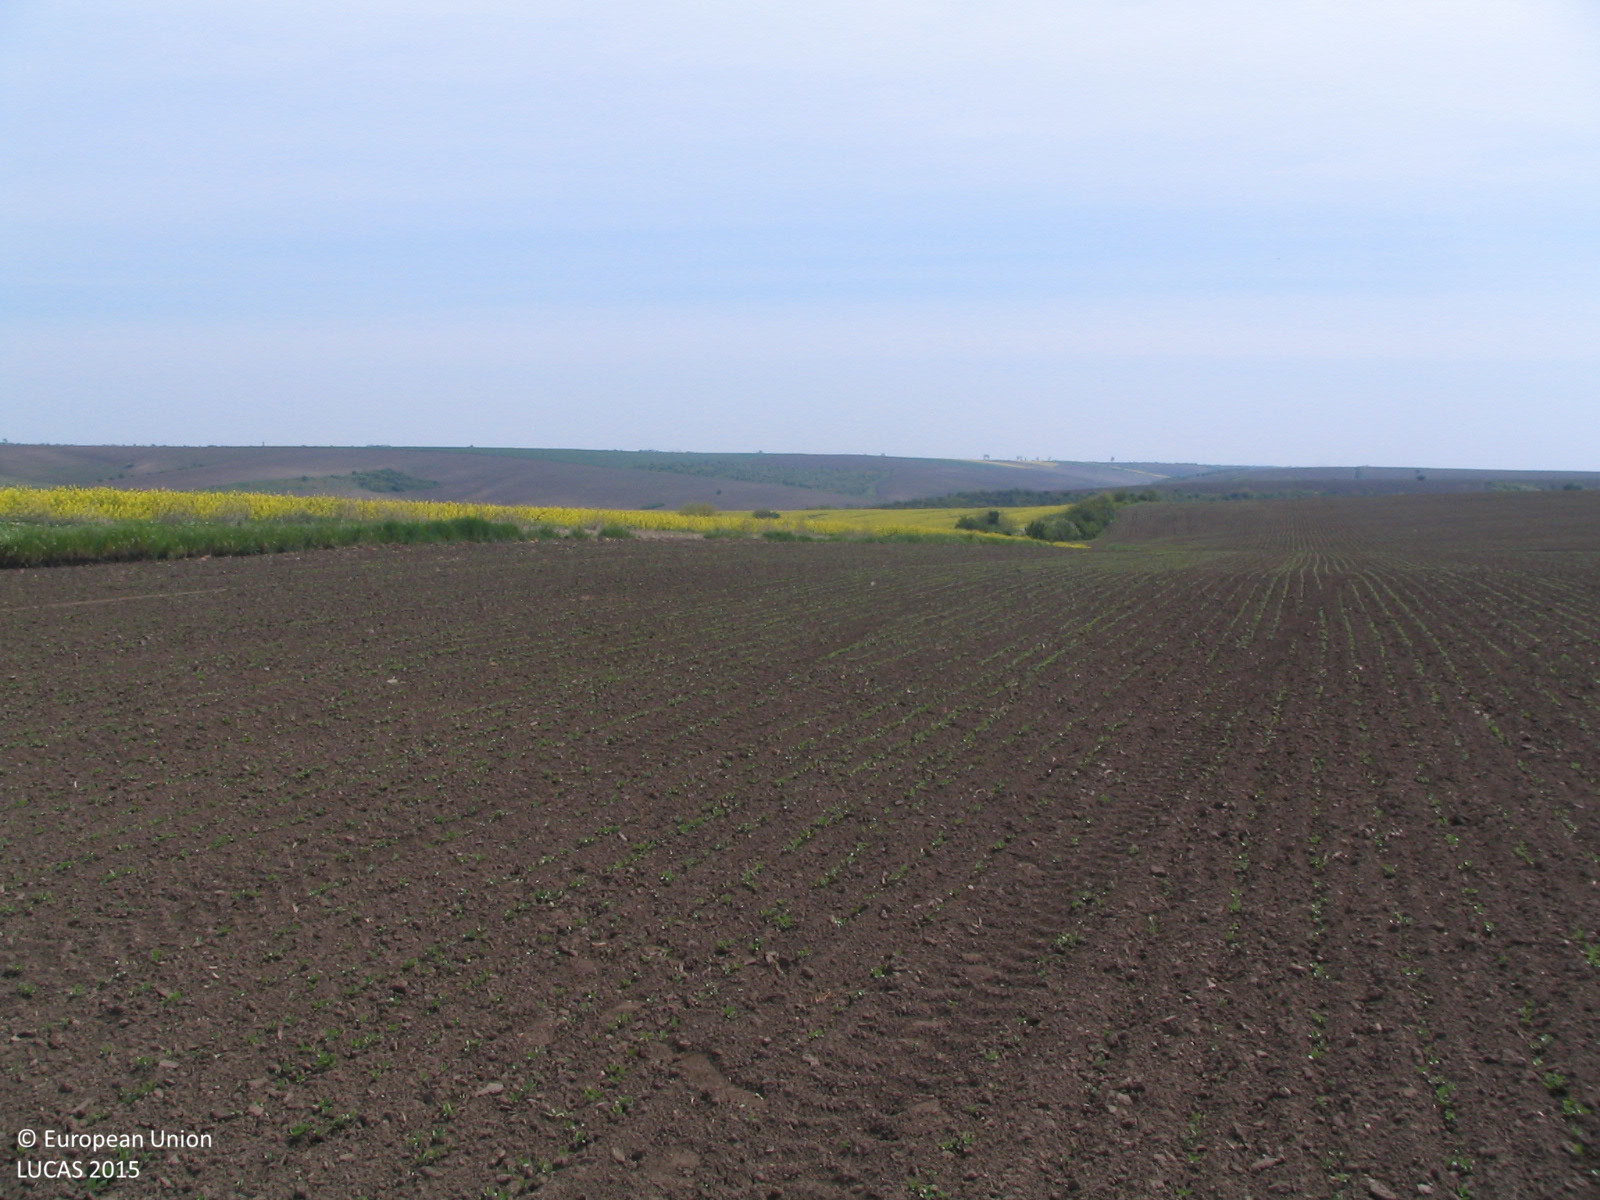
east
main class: Cropland
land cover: Soya
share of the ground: < 10 %
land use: Agriculture (excluding fallow land and kitchen gardens)
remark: Tilled/Sowed
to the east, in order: Soya; Grassland without tree/shrub cover; Rape and turnip rape
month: May
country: BG
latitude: 43.6651
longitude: 23.9050
